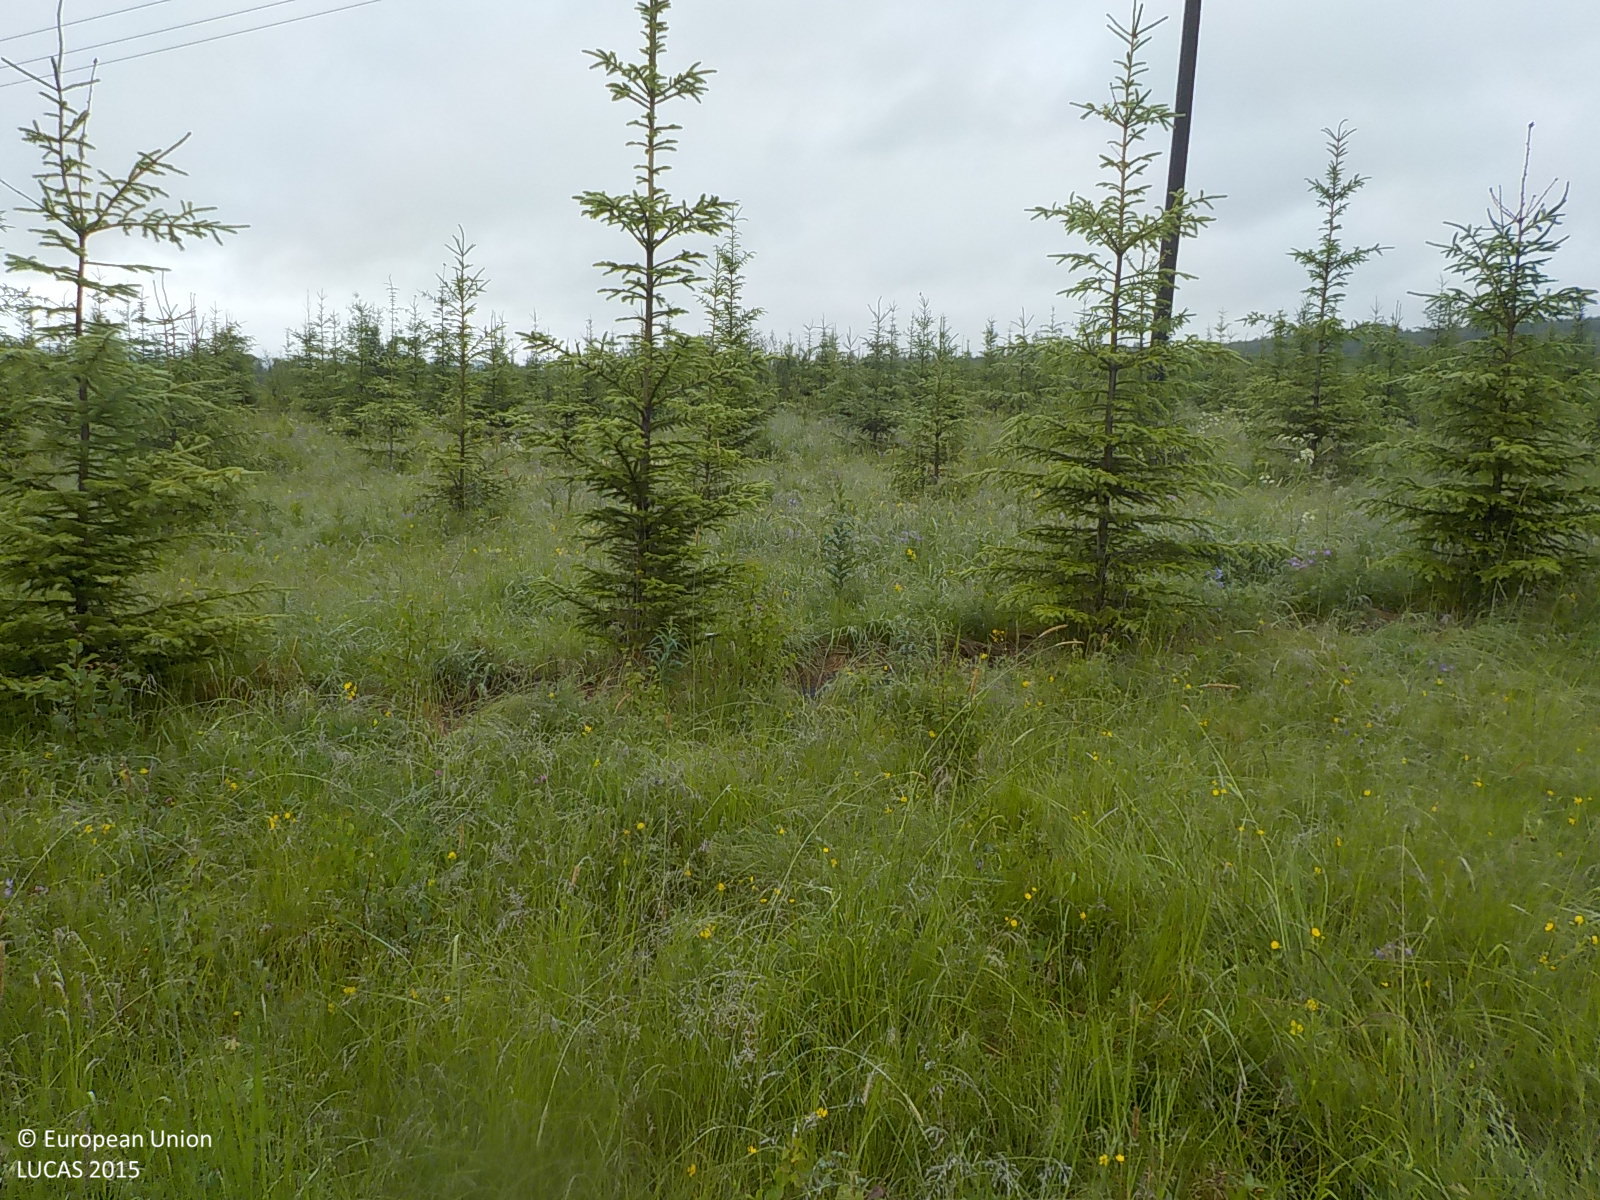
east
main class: Woodland
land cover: Spruce dominated coniferous woodland
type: boreal forest
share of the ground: 50 - 75 %
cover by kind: coniferous forest trees 50 %, herbaceous plants 50 %
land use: Forestry
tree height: < 5 m
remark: Nursery
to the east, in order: Spruce dominated coniferous woodland; Electric lines; Spruce dominated coniferous woodland
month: July
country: SE
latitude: 63.1729
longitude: 17.0264
